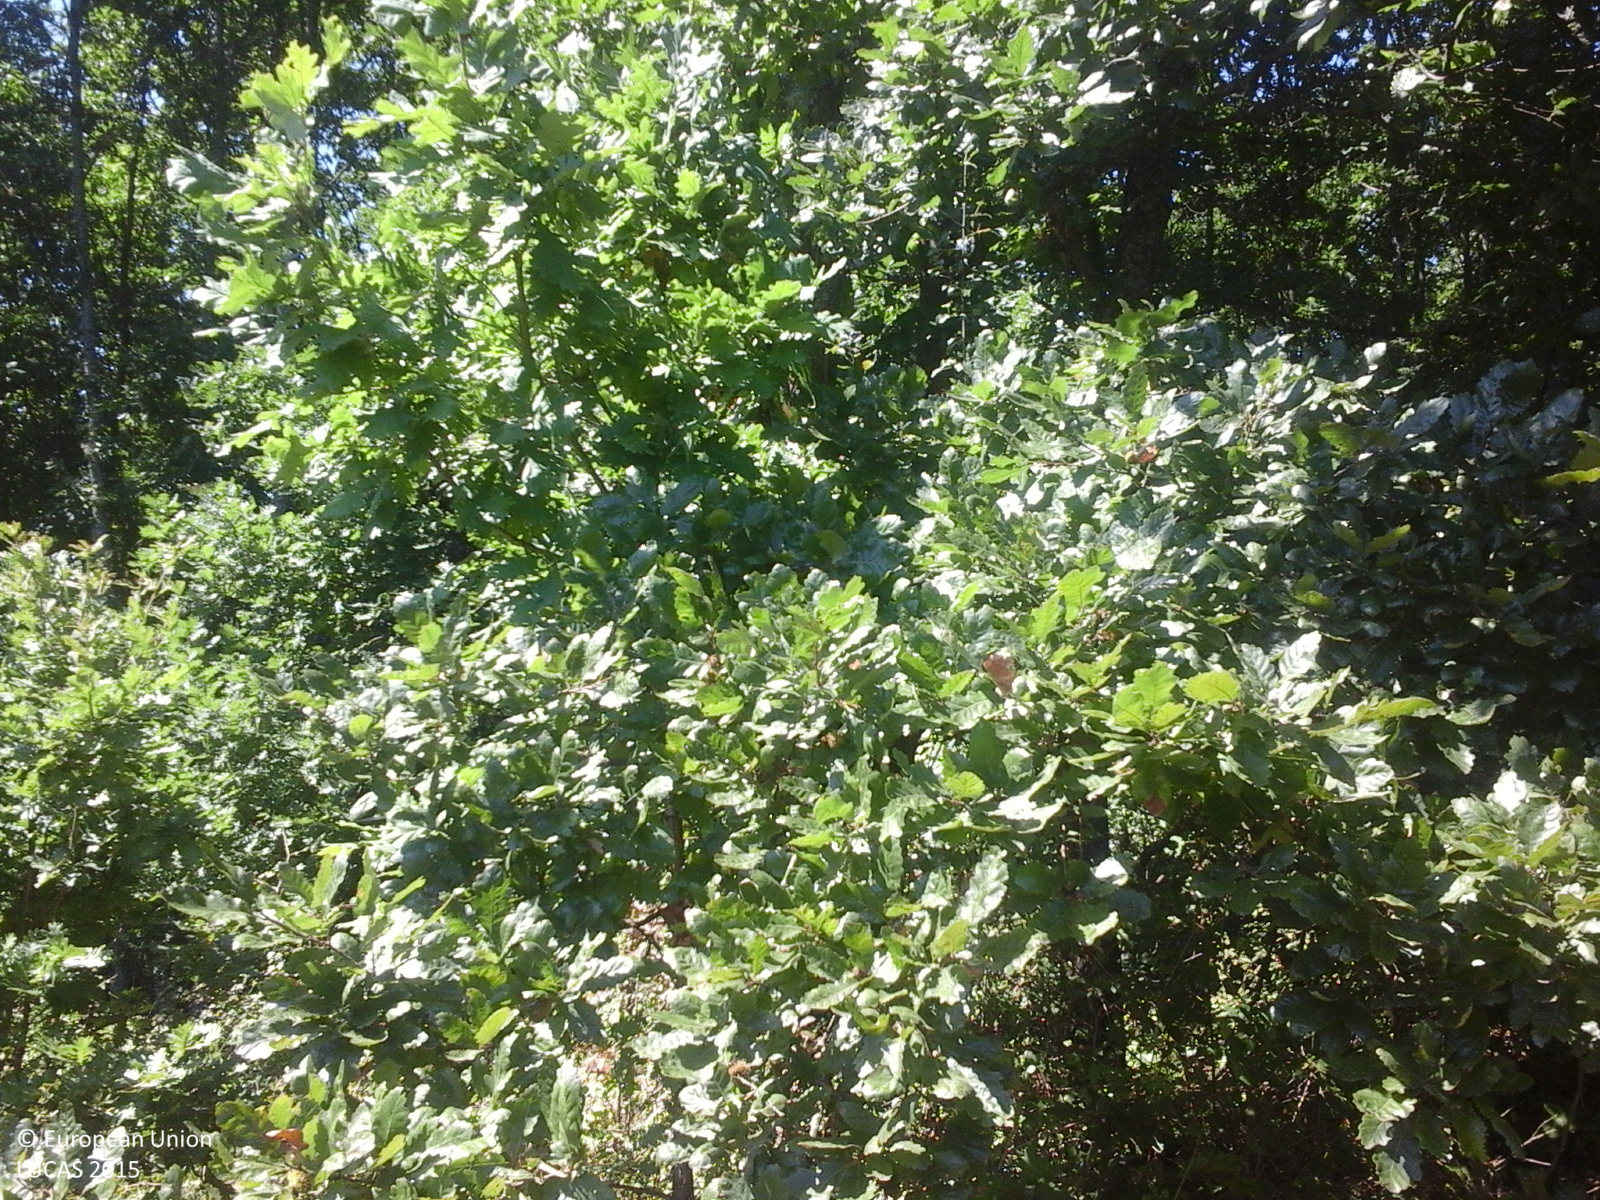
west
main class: Shrubland
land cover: Shrubland with sparse tree cover
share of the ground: > 75 %
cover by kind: shrubs 85 %, herbaceous plants 10 %, broadleaved forest trees 5 %
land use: Agriculture (excluding fallow land and kitchen gardens)
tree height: < 5 m
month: August
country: RO
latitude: 45.9512
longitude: 21.7914
